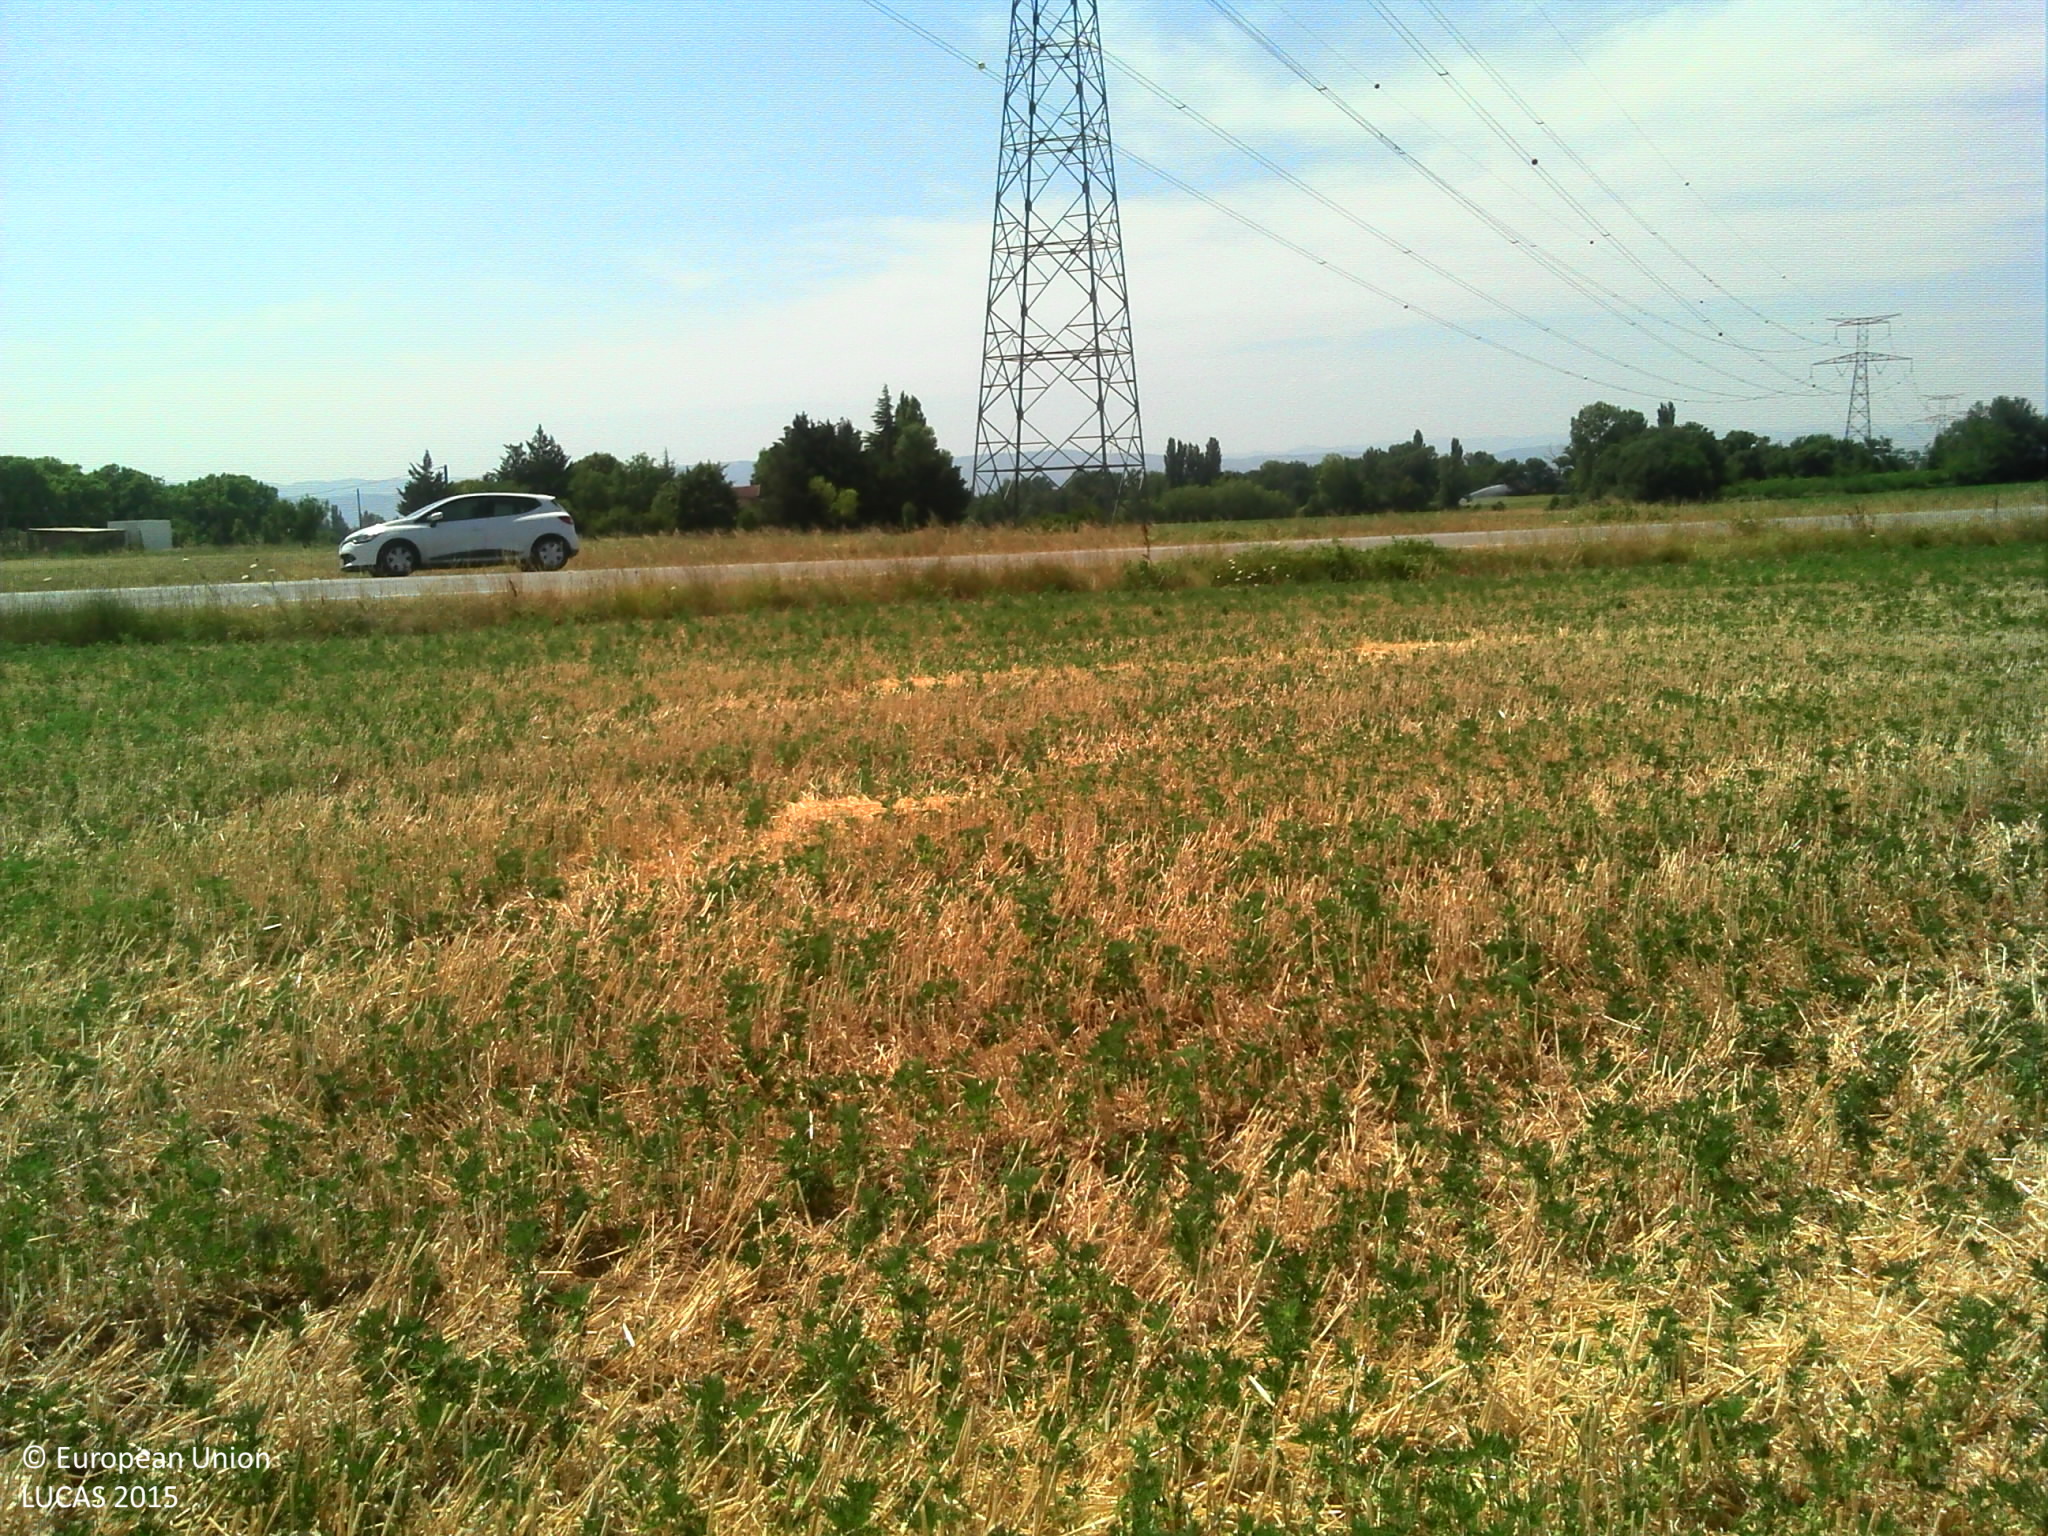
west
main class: Cropland
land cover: Barley
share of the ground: > 75 %
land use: Agriculture (excluding fallow land and kitchen gardens)
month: July
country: FR
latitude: 44.9538
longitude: 5.0242
